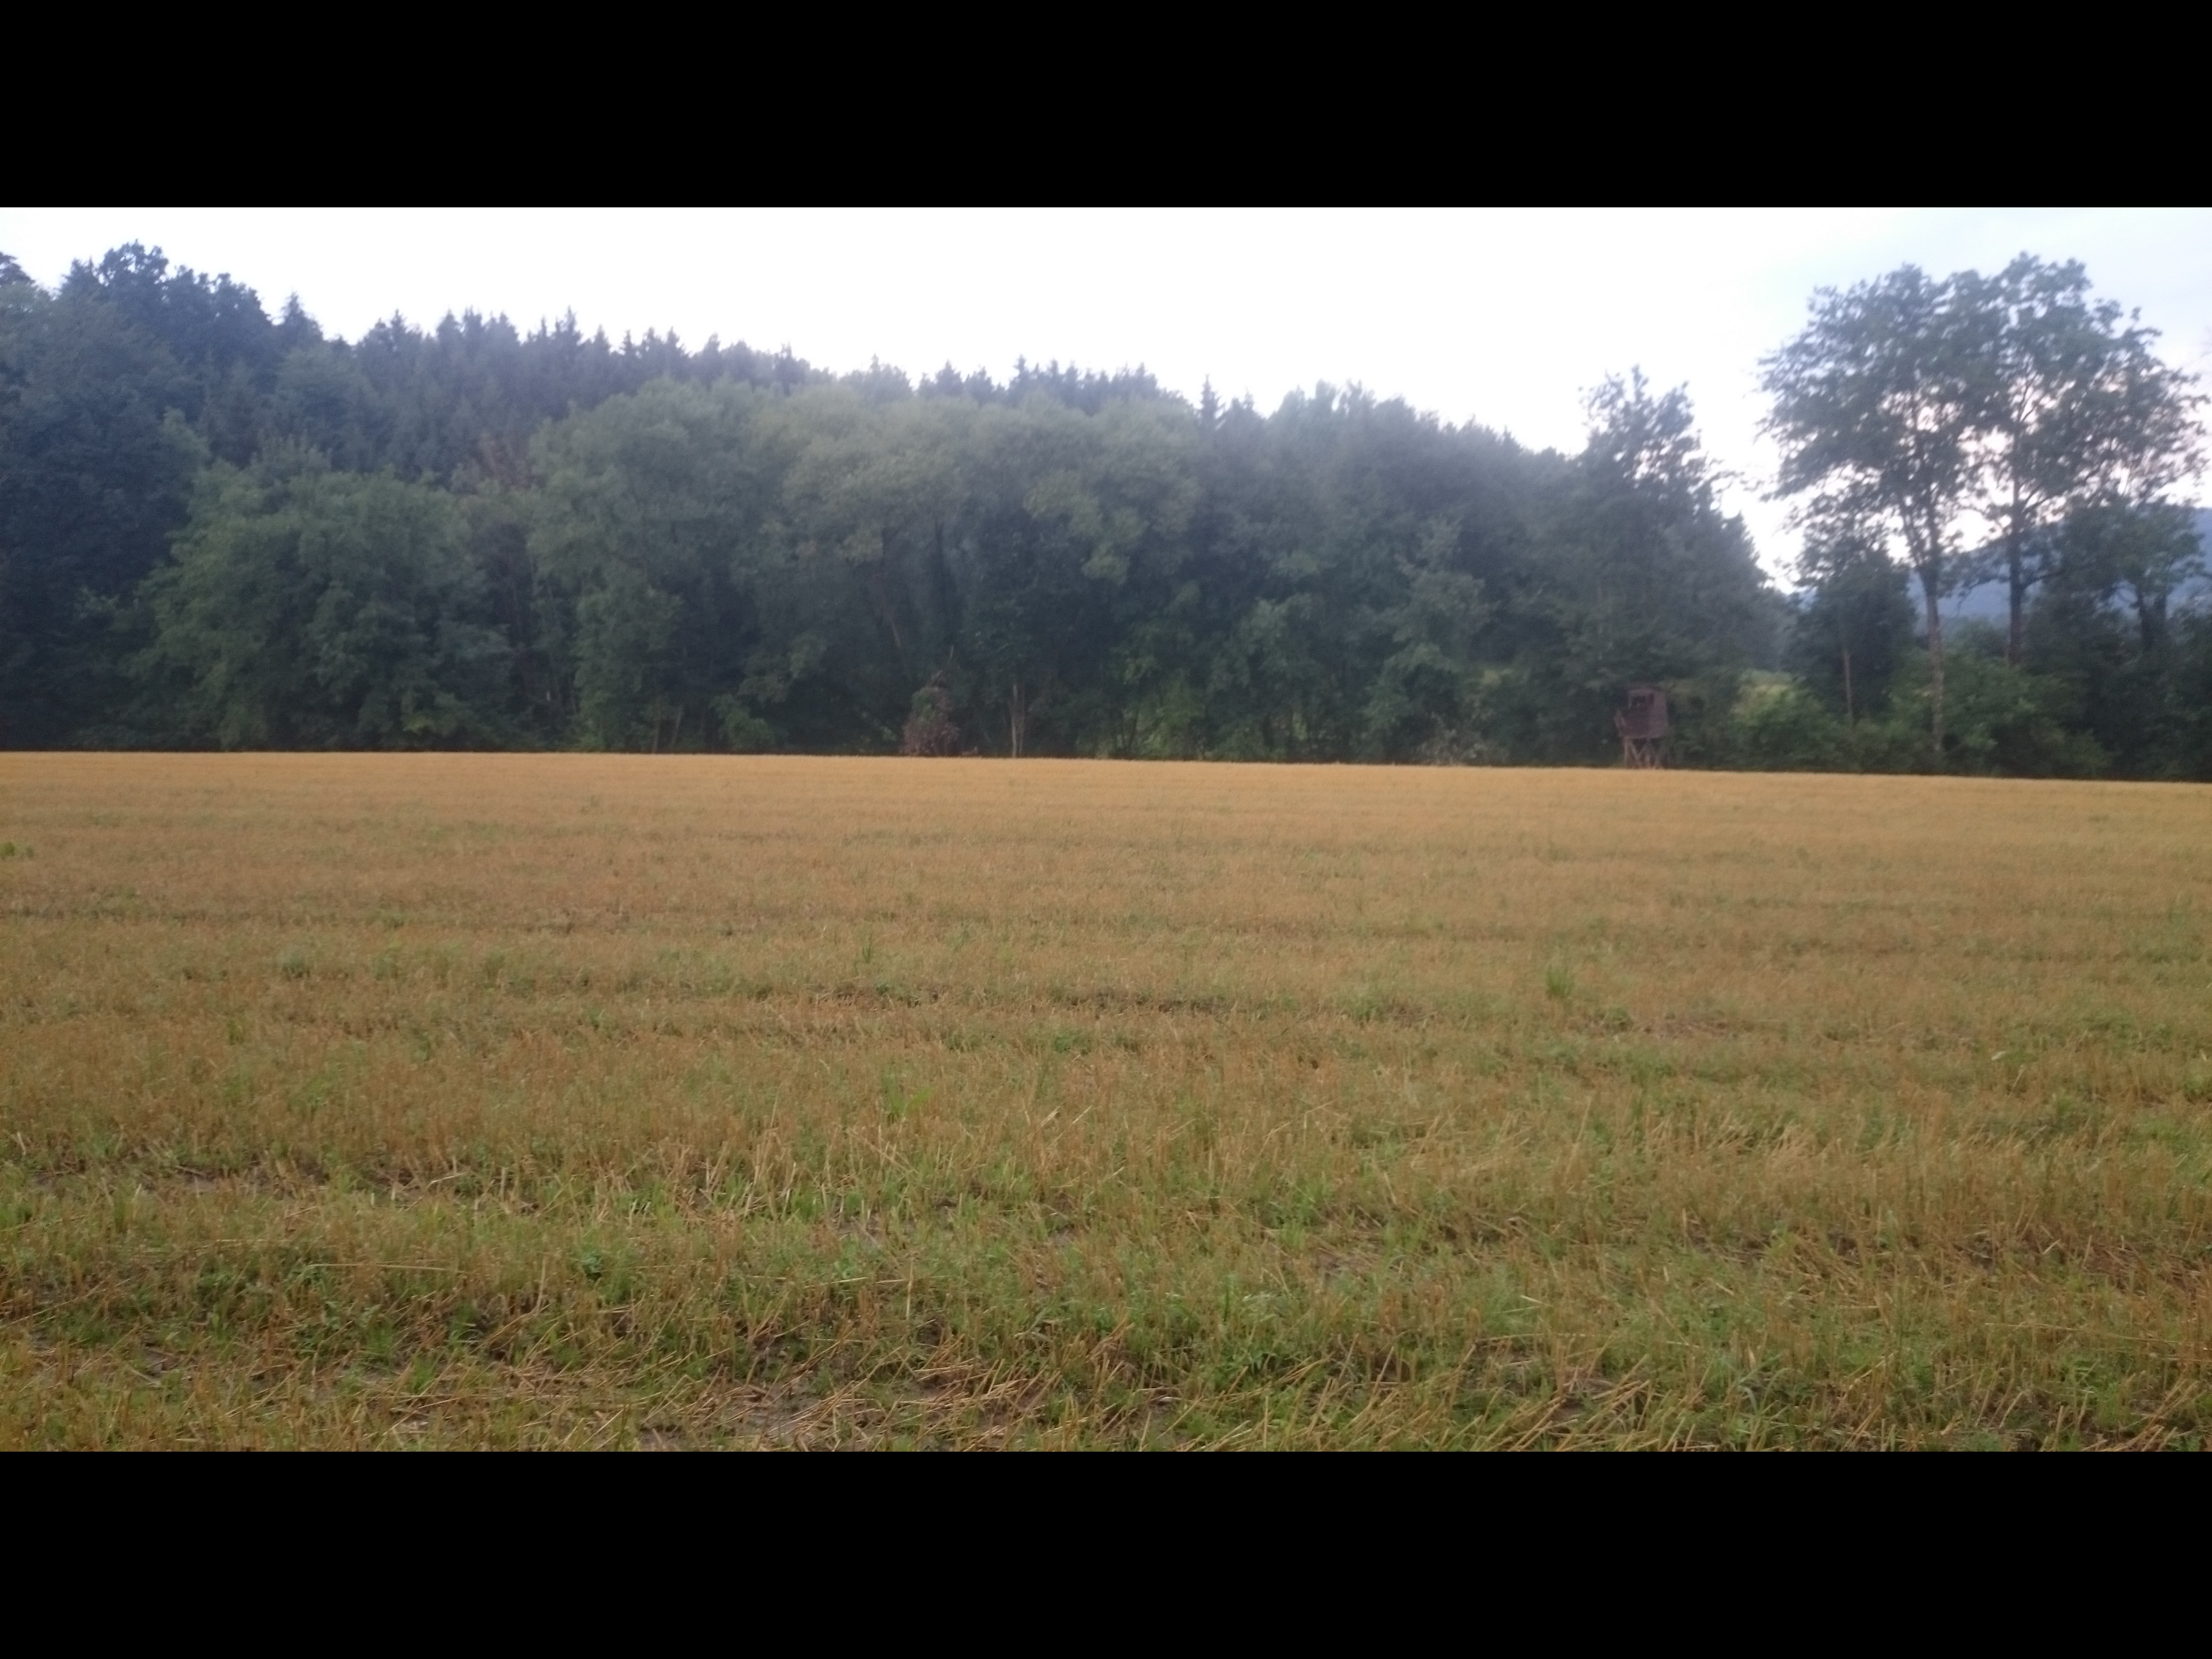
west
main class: Grassland
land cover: Spontaneously vegetated surfaces
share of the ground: > 75 %
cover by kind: herbaceous plants 100 %
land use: Agriculture (excluding fallow land and kitchen gardens)
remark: Harvested field
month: July
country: AT
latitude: 47.1926
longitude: 15.6892
